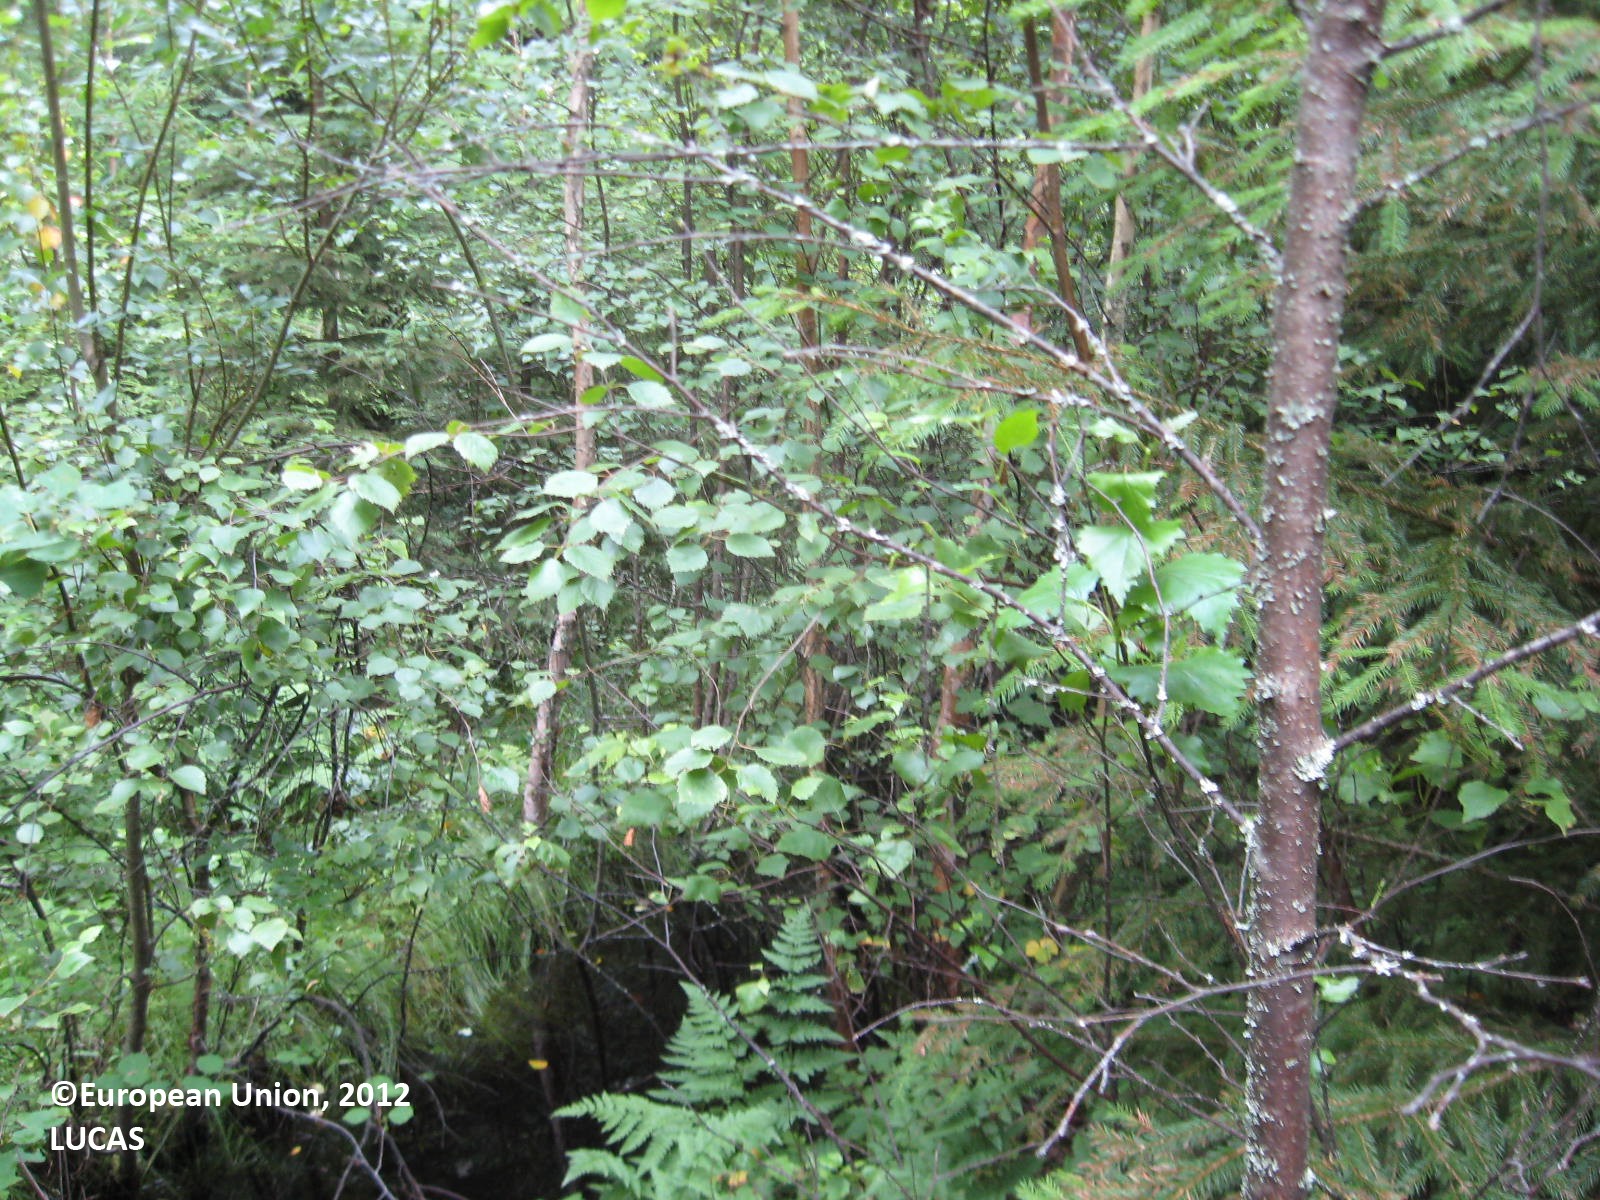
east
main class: Woodland
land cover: Other mixed woodland
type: boreal forest
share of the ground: > 75 %
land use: Forestry
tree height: > 5 m
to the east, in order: Other mixed woodland; Ditches and canals; Spruce dominated mixed woodland; Ditches and canals; Other mixed woodland; Other coniferous woodland; Other mixed woodland
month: July
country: FI
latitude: 61.8387
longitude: 21.5396
